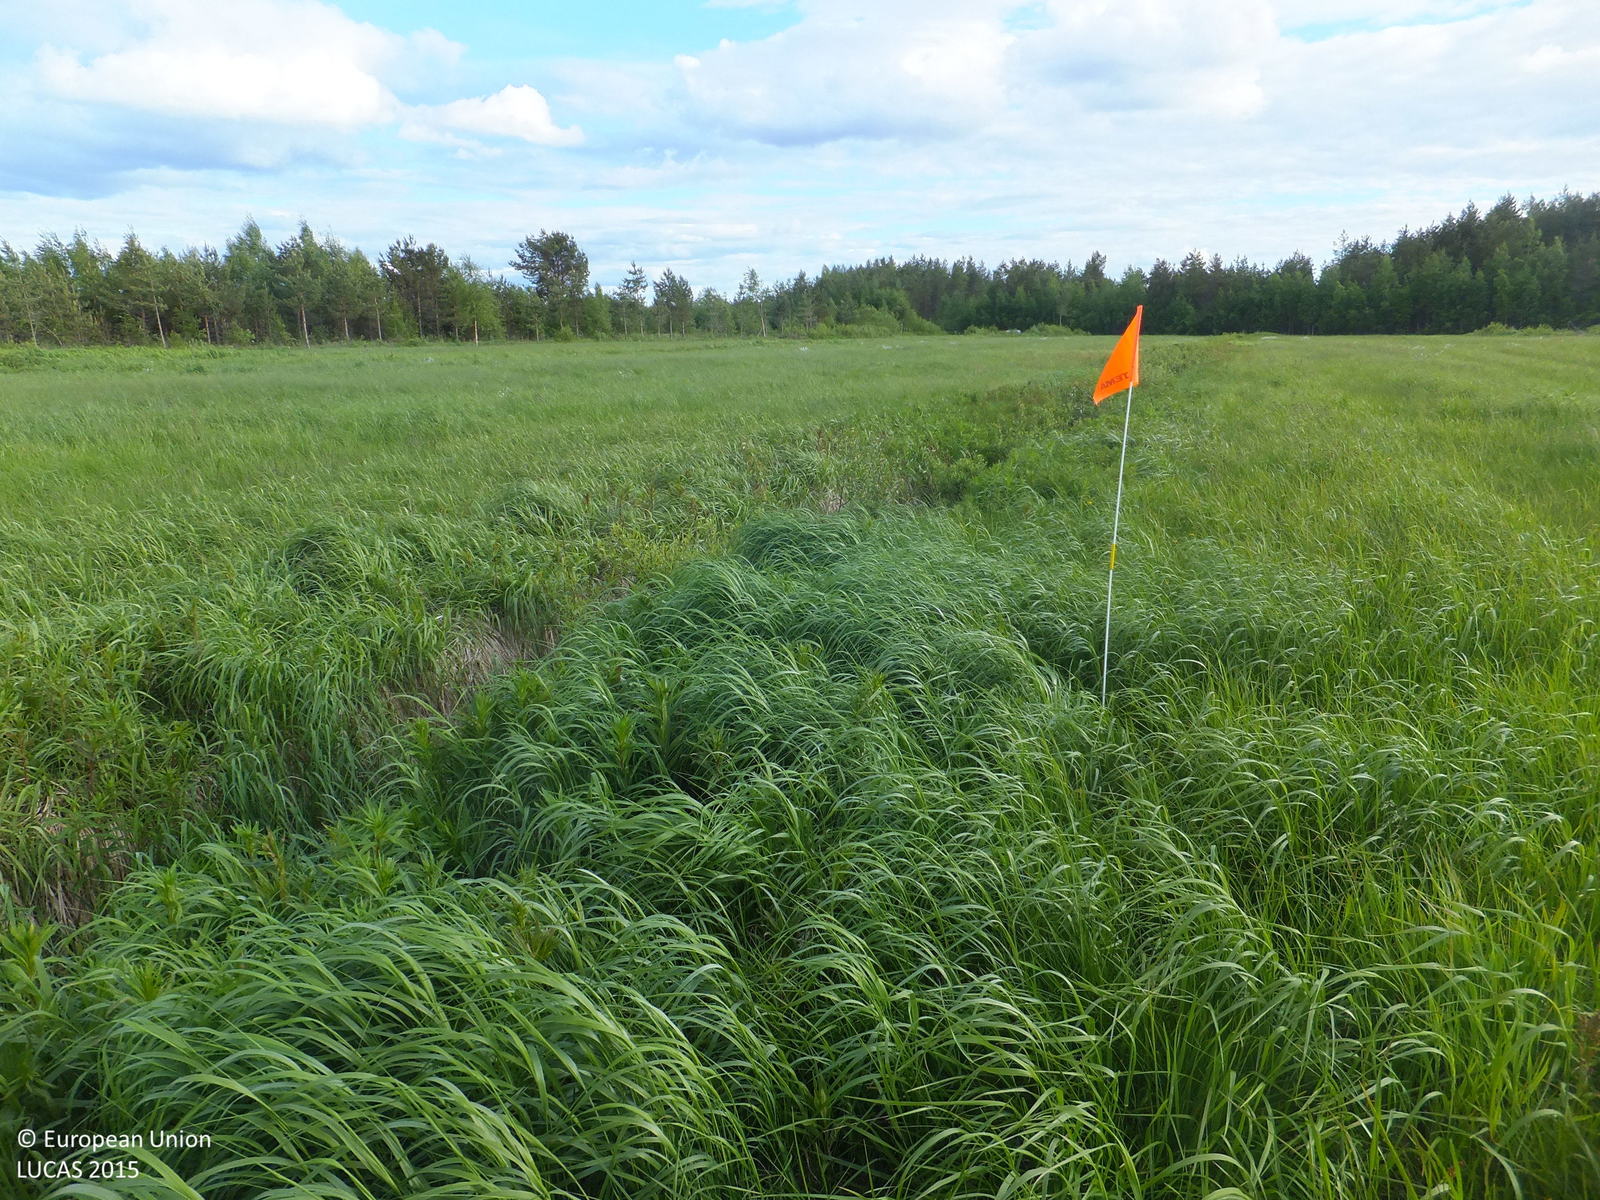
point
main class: Cropland
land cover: Temporary grasslands
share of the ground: > 75 %
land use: Agriculture (excluding fallow land and kitchen gardens)
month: June
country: FI
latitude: 63.6777
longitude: 24.2428
